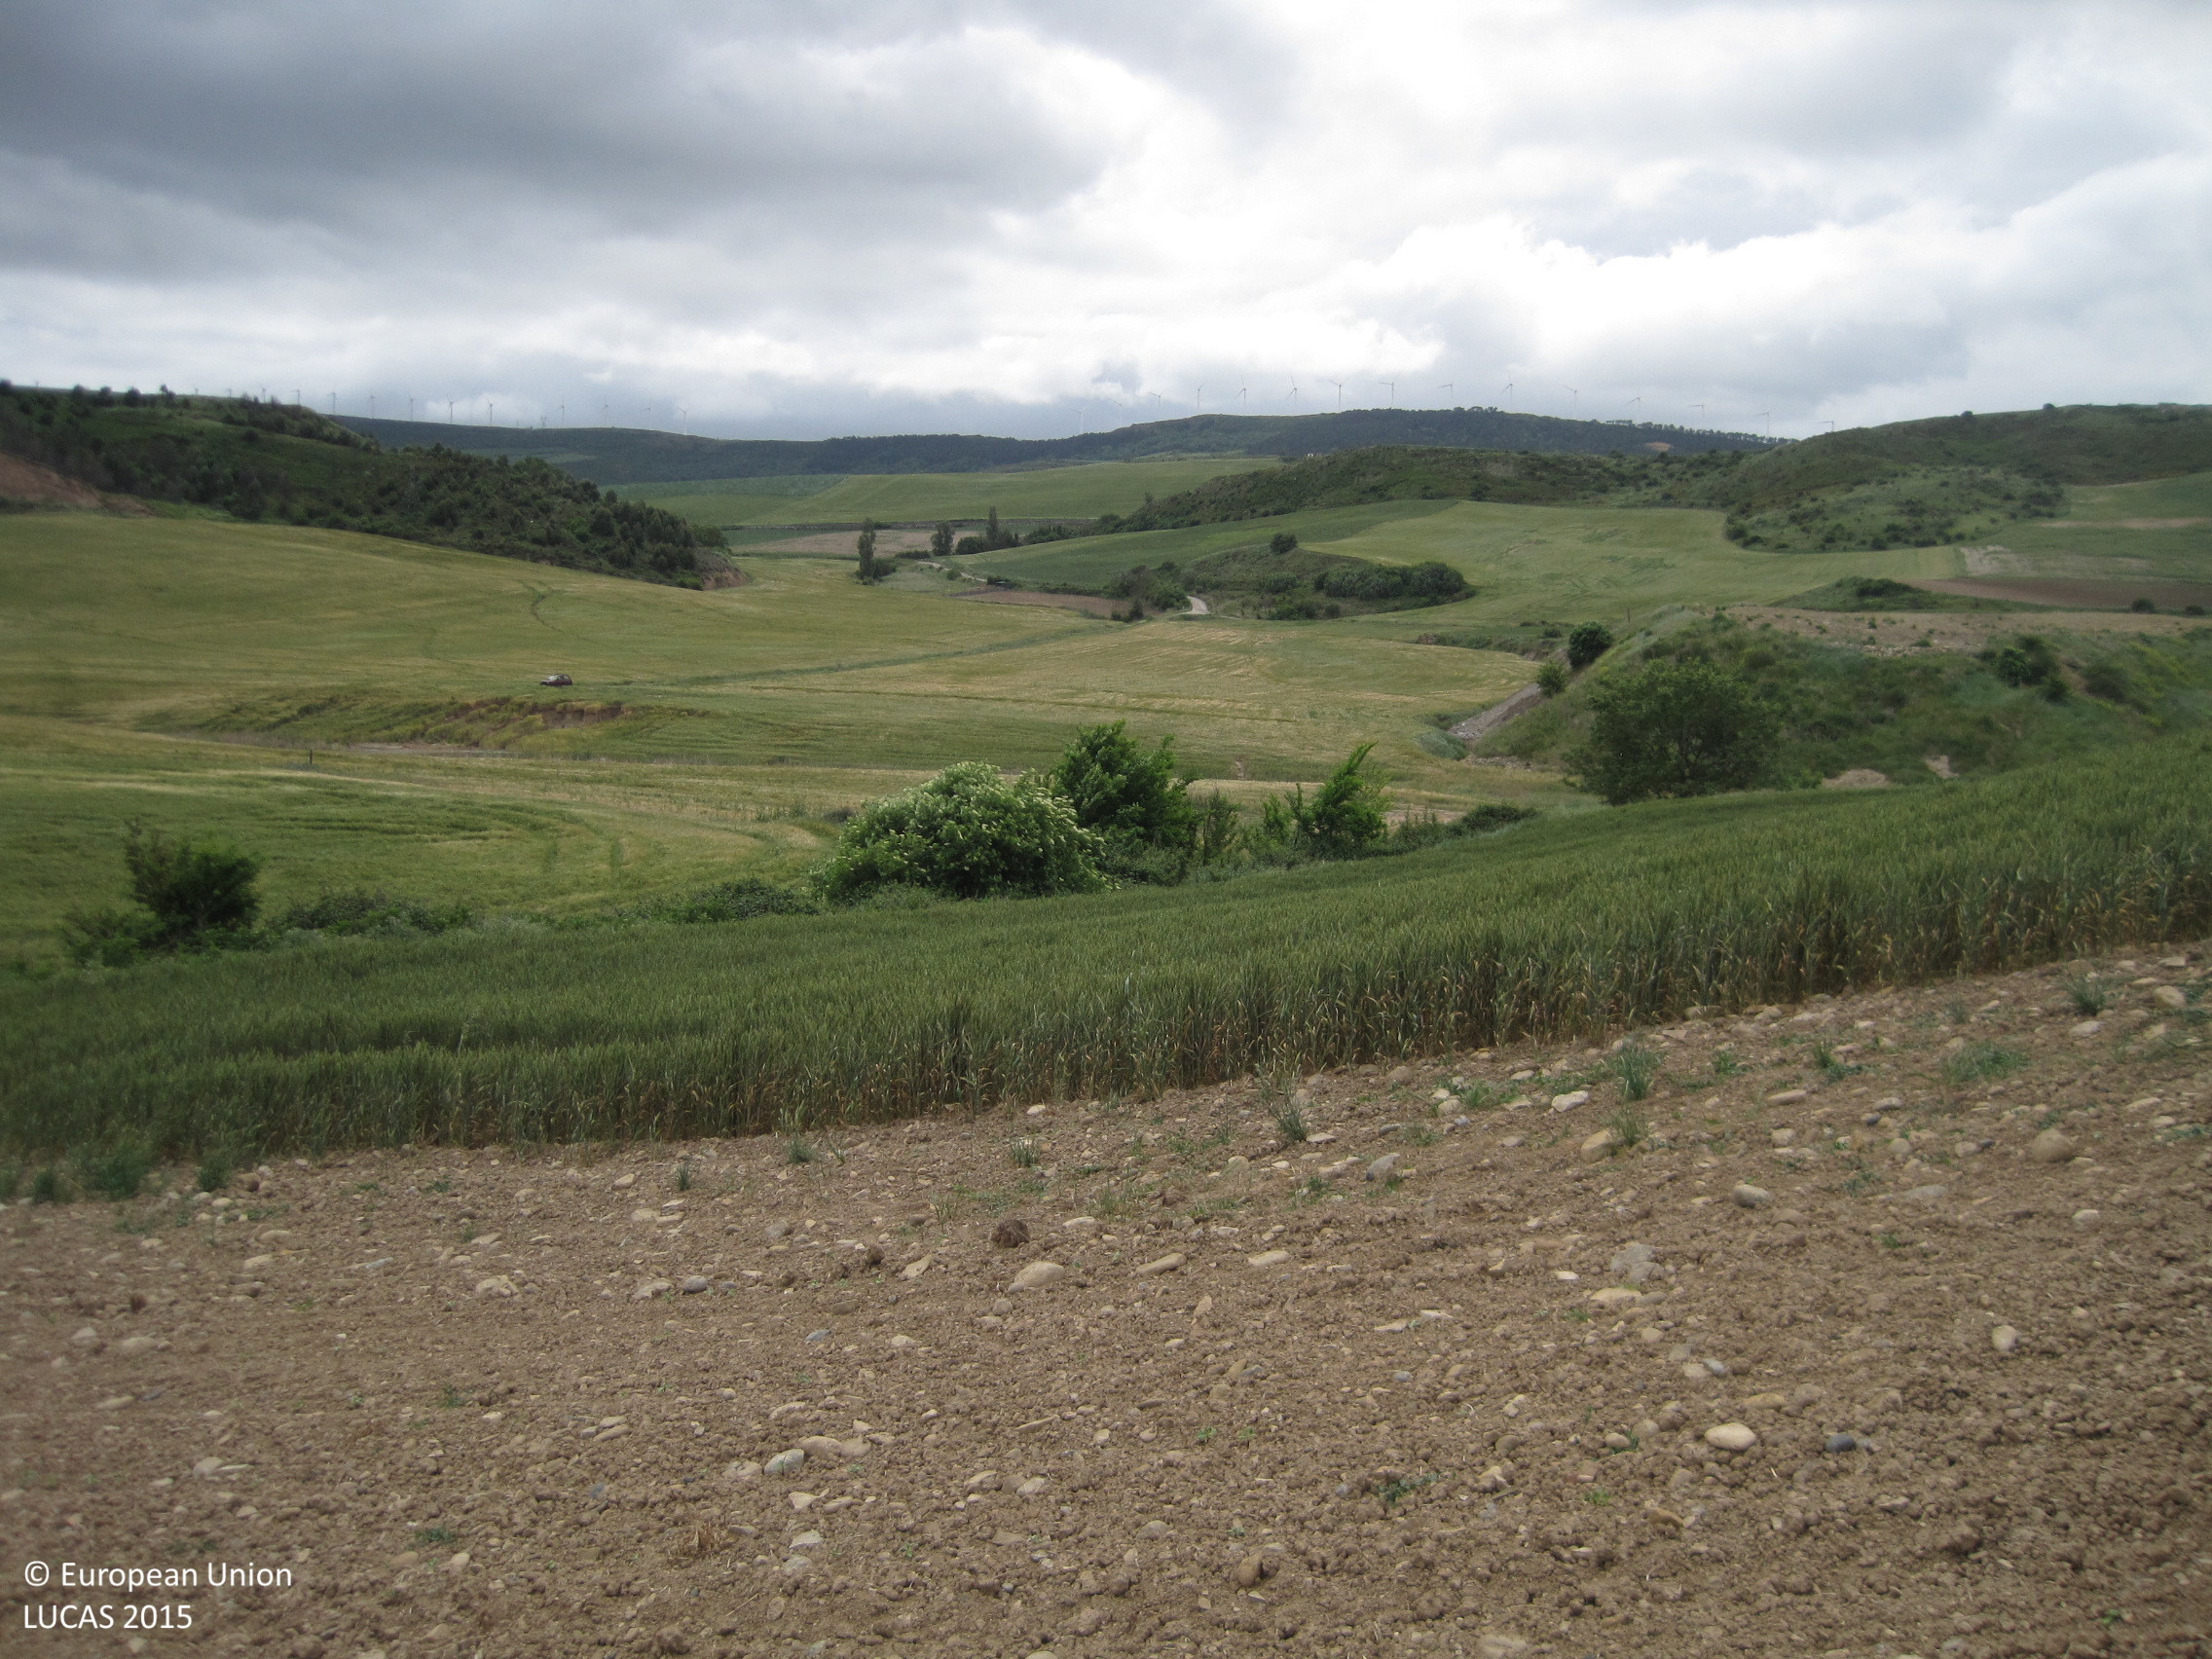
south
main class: Cropland
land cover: Sunflower
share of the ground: < 10 %
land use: Agriculture (excluding fallow land and kitchen gardens)
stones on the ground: < 10 %
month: May
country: ES
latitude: 42.7685
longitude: -1.7598
